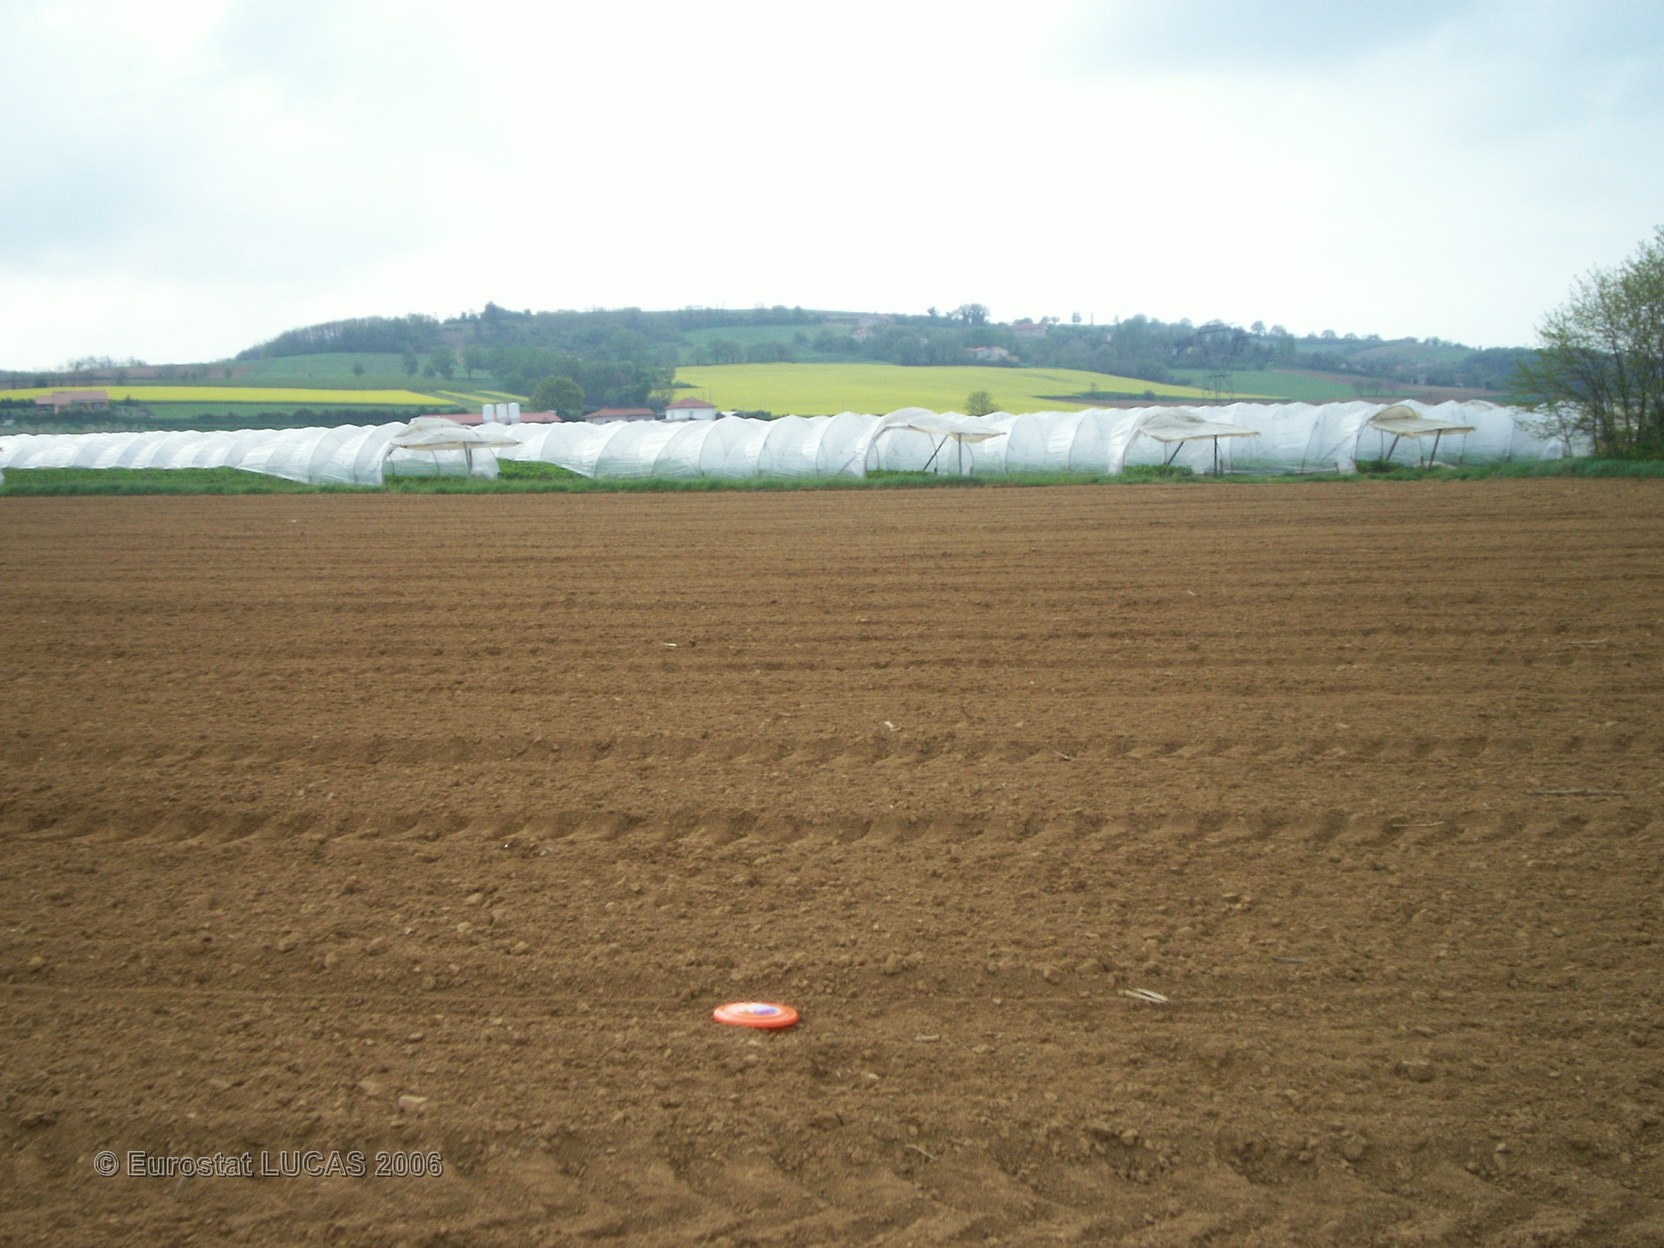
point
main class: Cropland
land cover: Maize
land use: Agriculture (excluding fallow land and kitchen gardens)
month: June
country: FR
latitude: 45.3791
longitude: 4.8581
